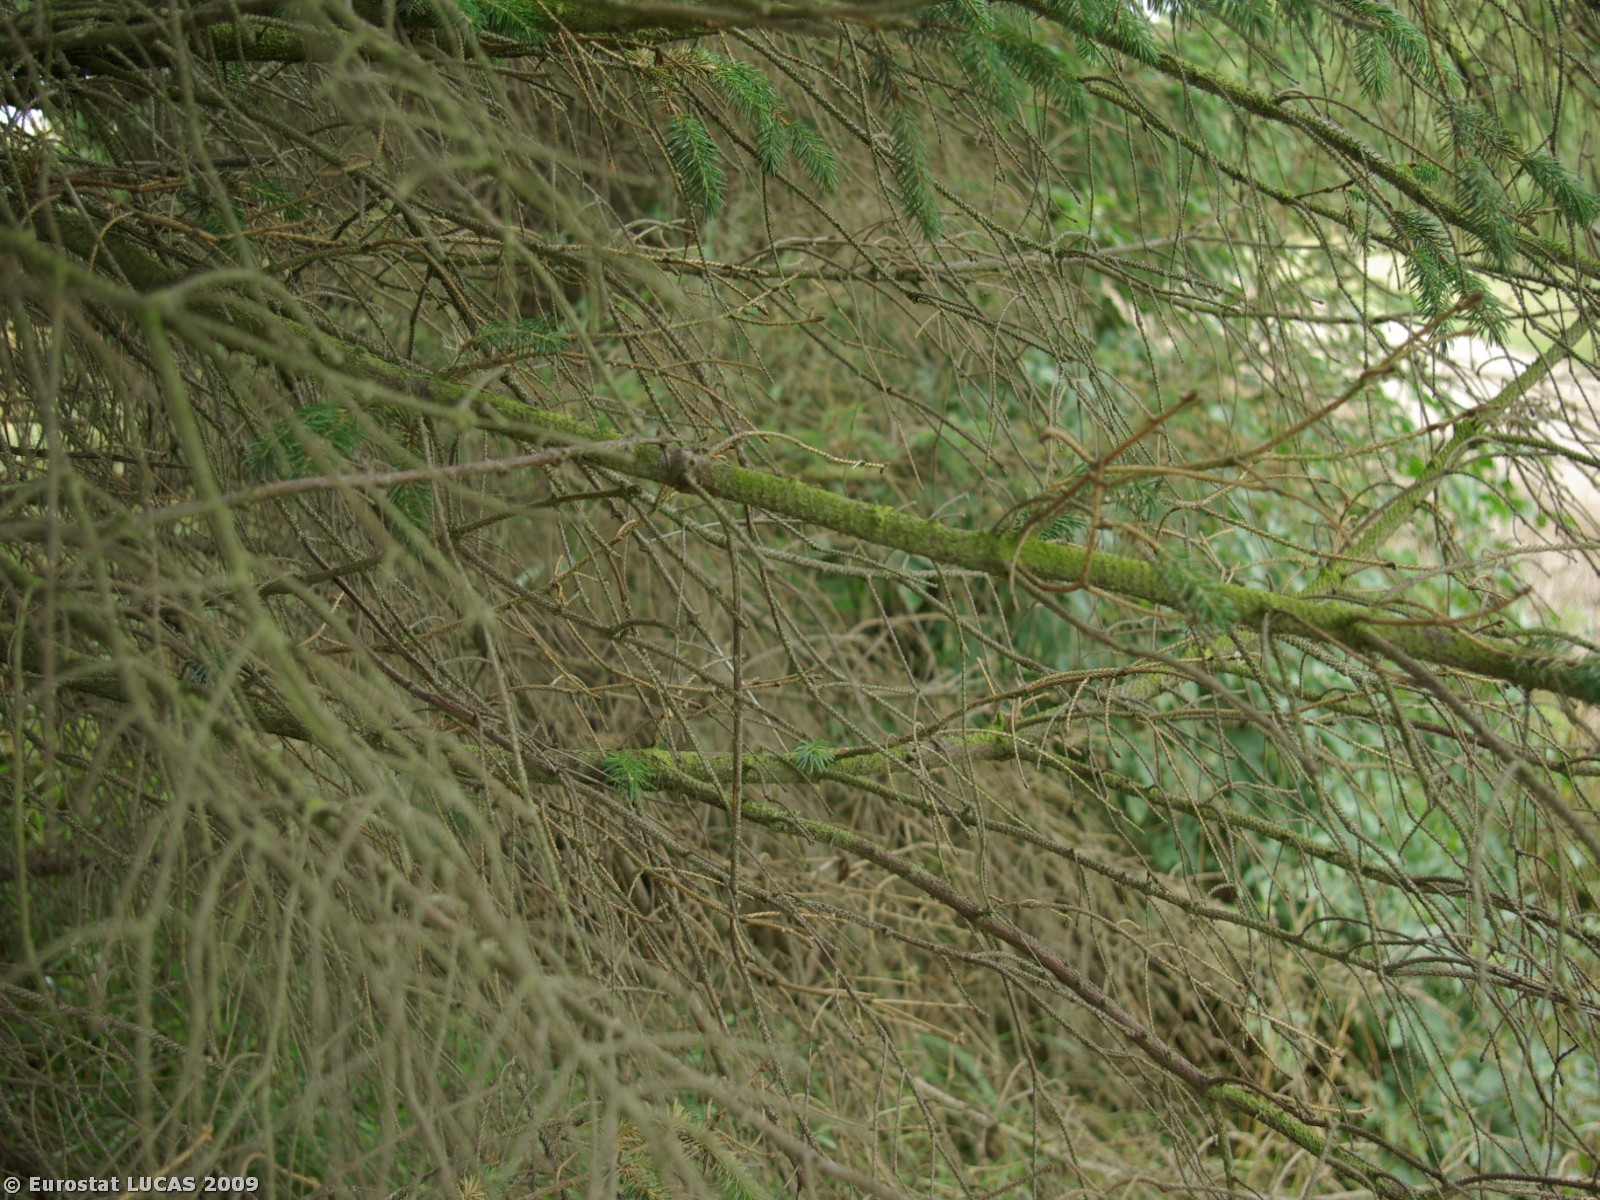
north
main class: Woodland
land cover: Coniferous woodland
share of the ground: 25 - 50 %
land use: Unused
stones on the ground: < 10 %
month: July
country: DK
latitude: 55.1218
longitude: 8.8249
